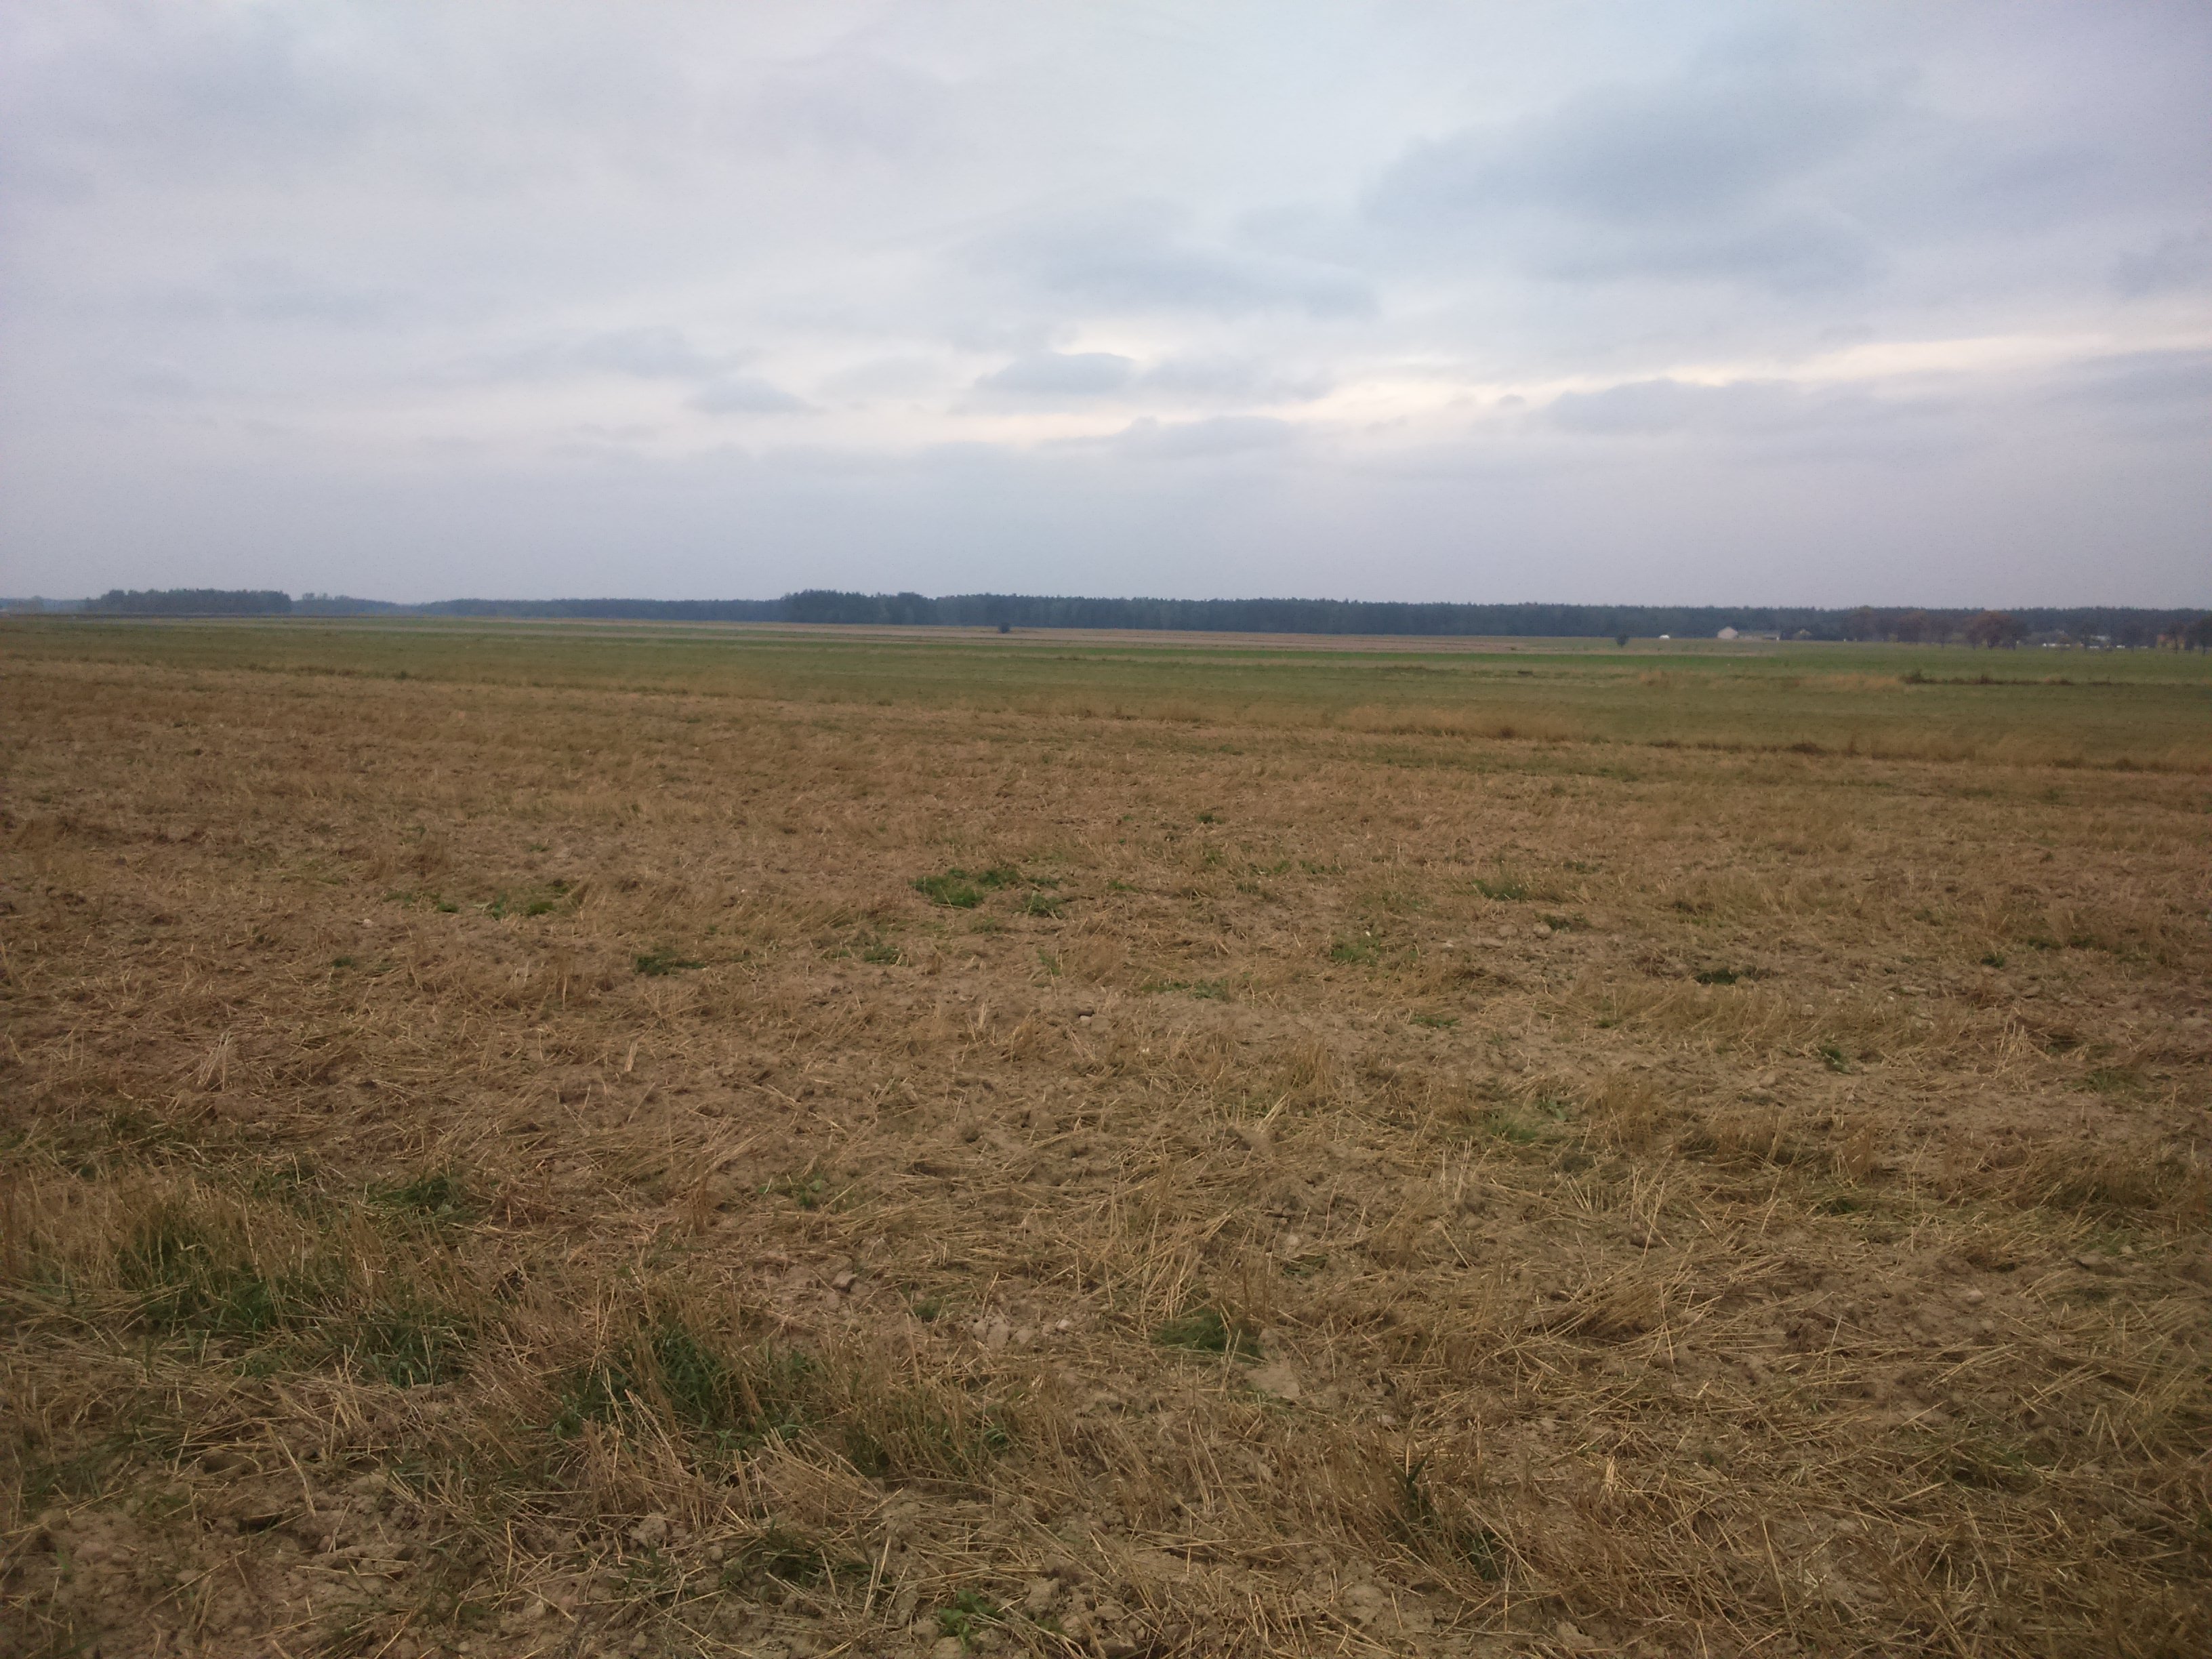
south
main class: Cropland
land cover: Common wheat
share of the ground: 25 - 50 %
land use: Agriculture (excluding fallow land and kitchen gardens)
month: October
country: PL
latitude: 52.7344
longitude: 22.3107
